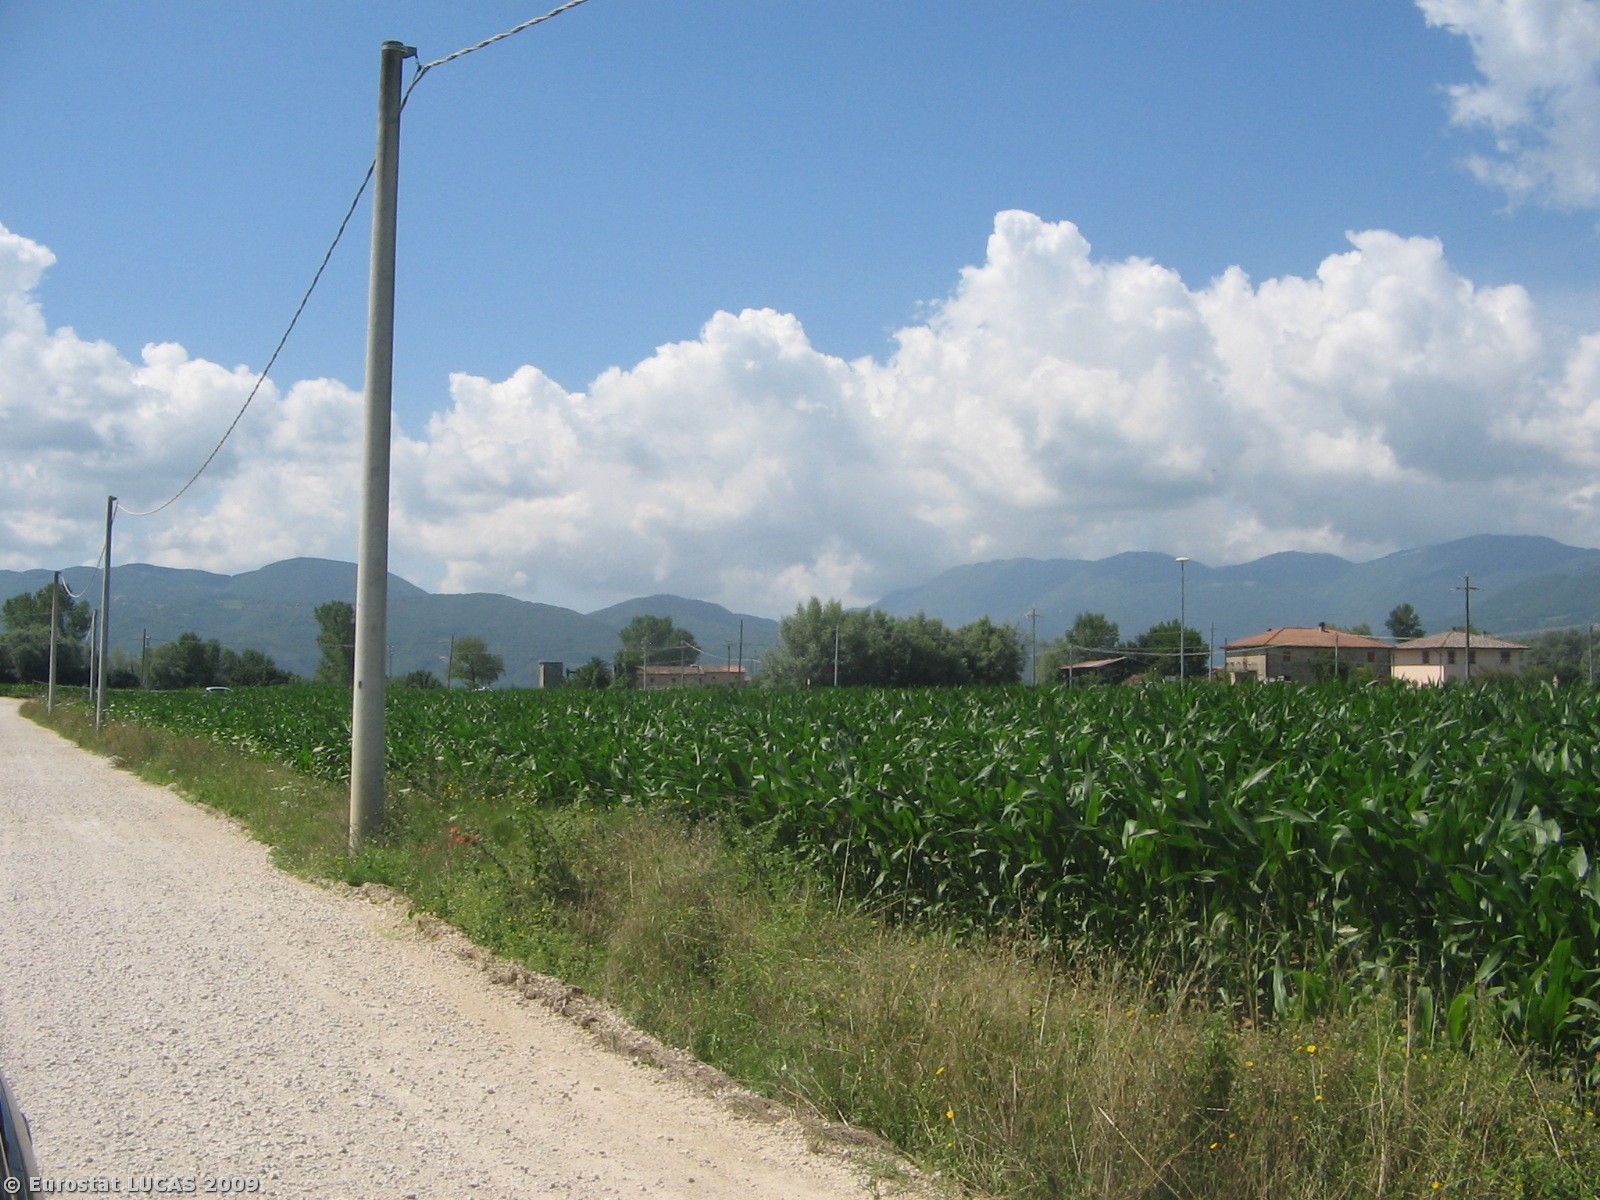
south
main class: Cropland
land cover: Maize
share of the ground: > 75 %
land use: Agriculture (excluding fallow land and kitchen gardens)
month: July
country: IT
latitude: 42.4340
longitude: 12.8230
